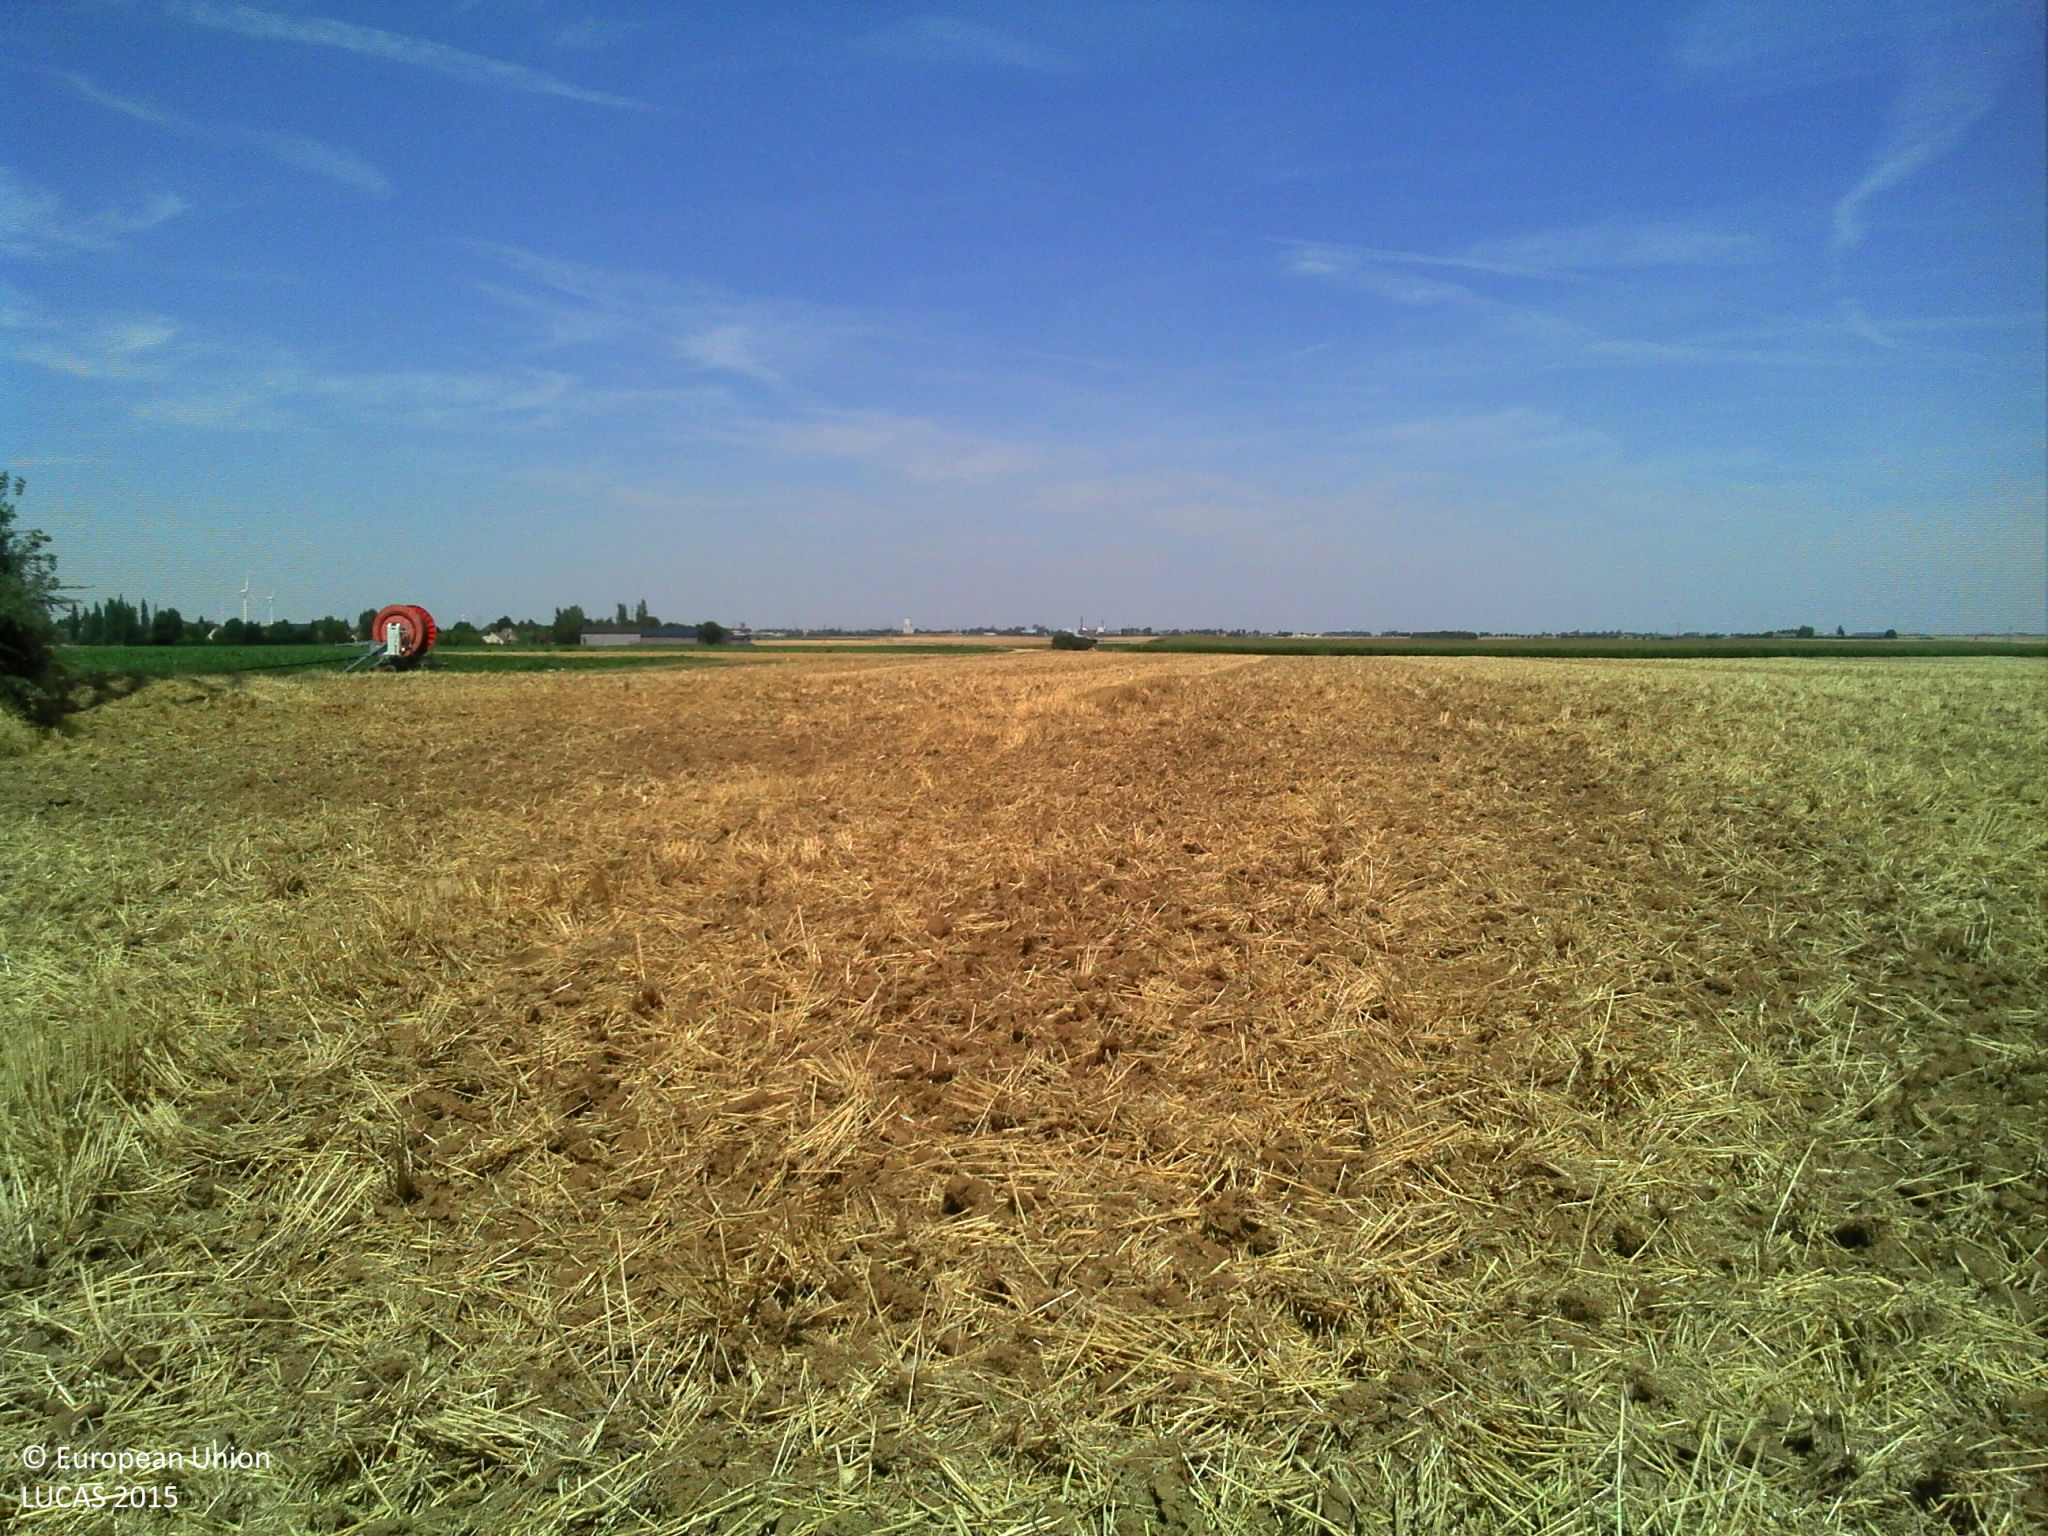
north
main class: Cropland
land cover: Triticale
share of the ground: > 75 %
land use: Agriculture (excluding fallow land and kitchen gardens)
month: August
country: FR
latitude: 48.1448
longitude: 1.9363
